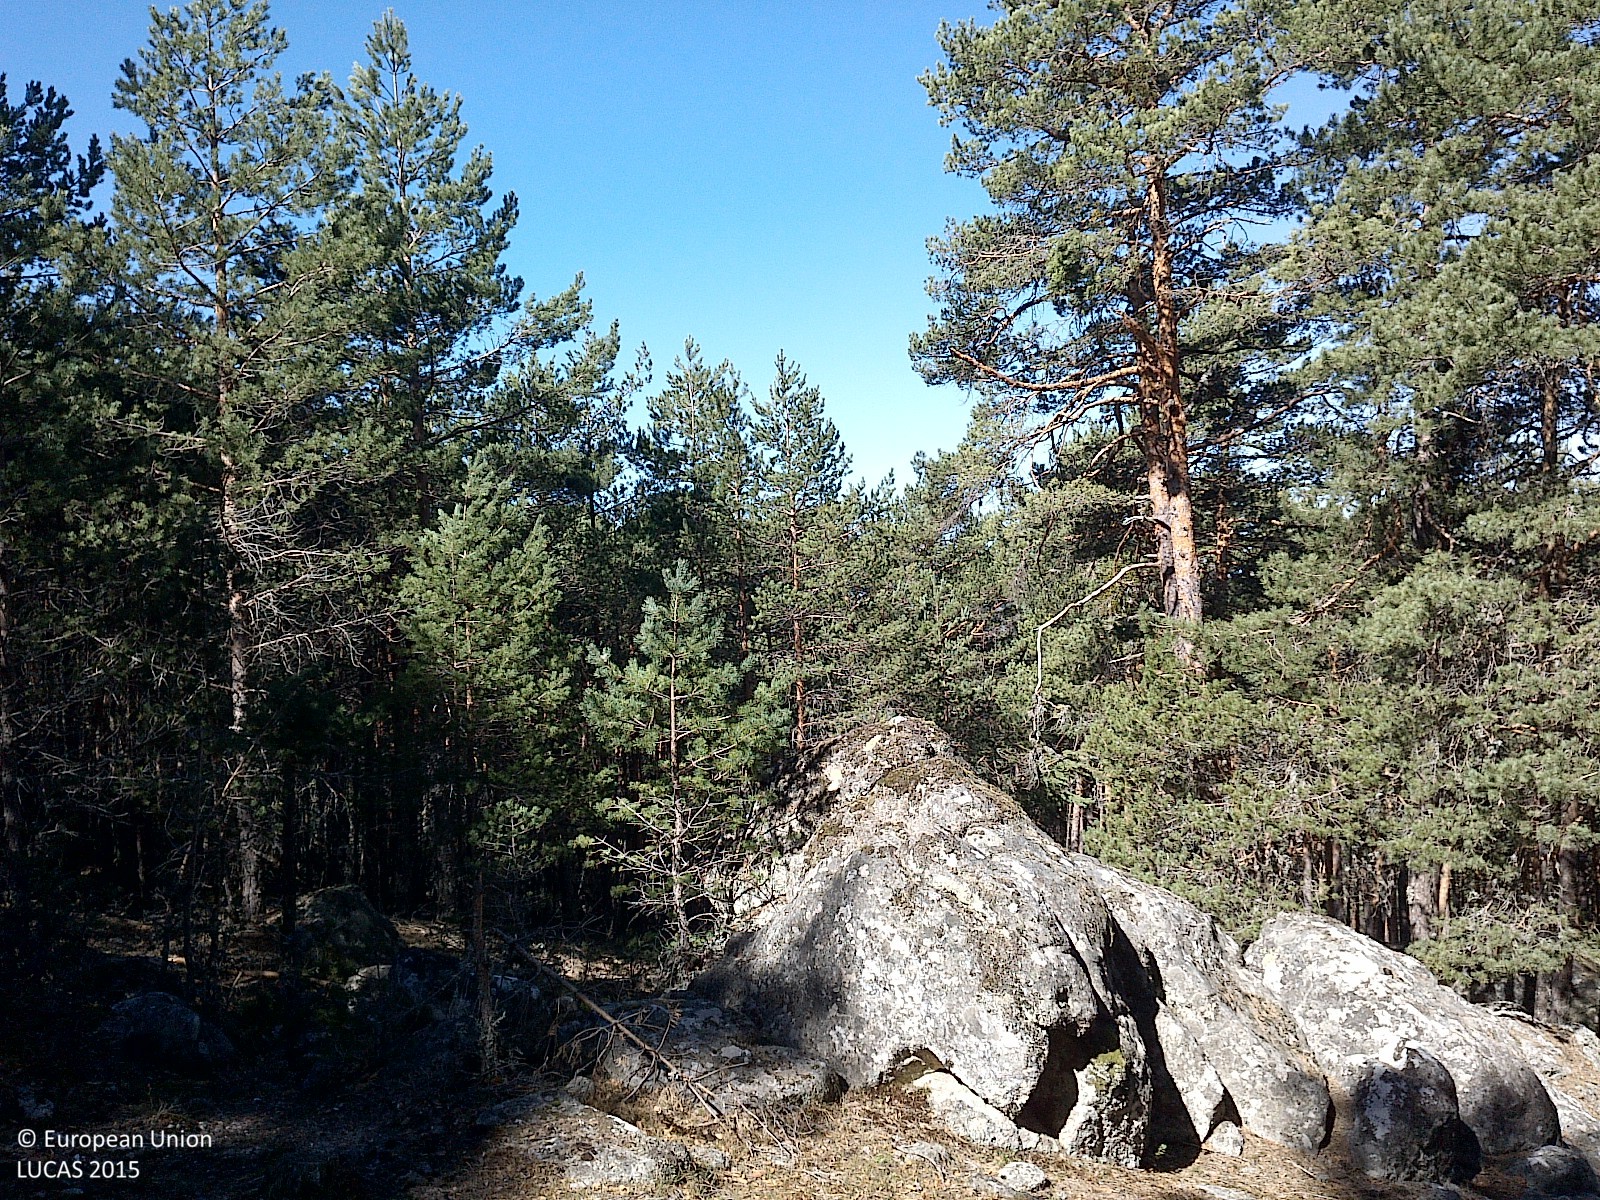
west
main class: Woodland
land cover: Pine dominated coniferous woodland
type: coniferous forest of the mediterranean region
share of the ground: > 75 %
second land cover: Grassland without tree/shrub cover
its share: 10 - 25 %
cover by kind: coniferous forest trees 75 %, herbaceous plants 15 %, unconsolidated bare surface 10 %
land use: Forestry
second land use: Agriculture (excluding fallow land and kitchen gardens)
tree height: > 5 m
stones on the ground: 10 - 25 %
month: April
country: ES
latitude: 41.9292
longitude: -3.0835
